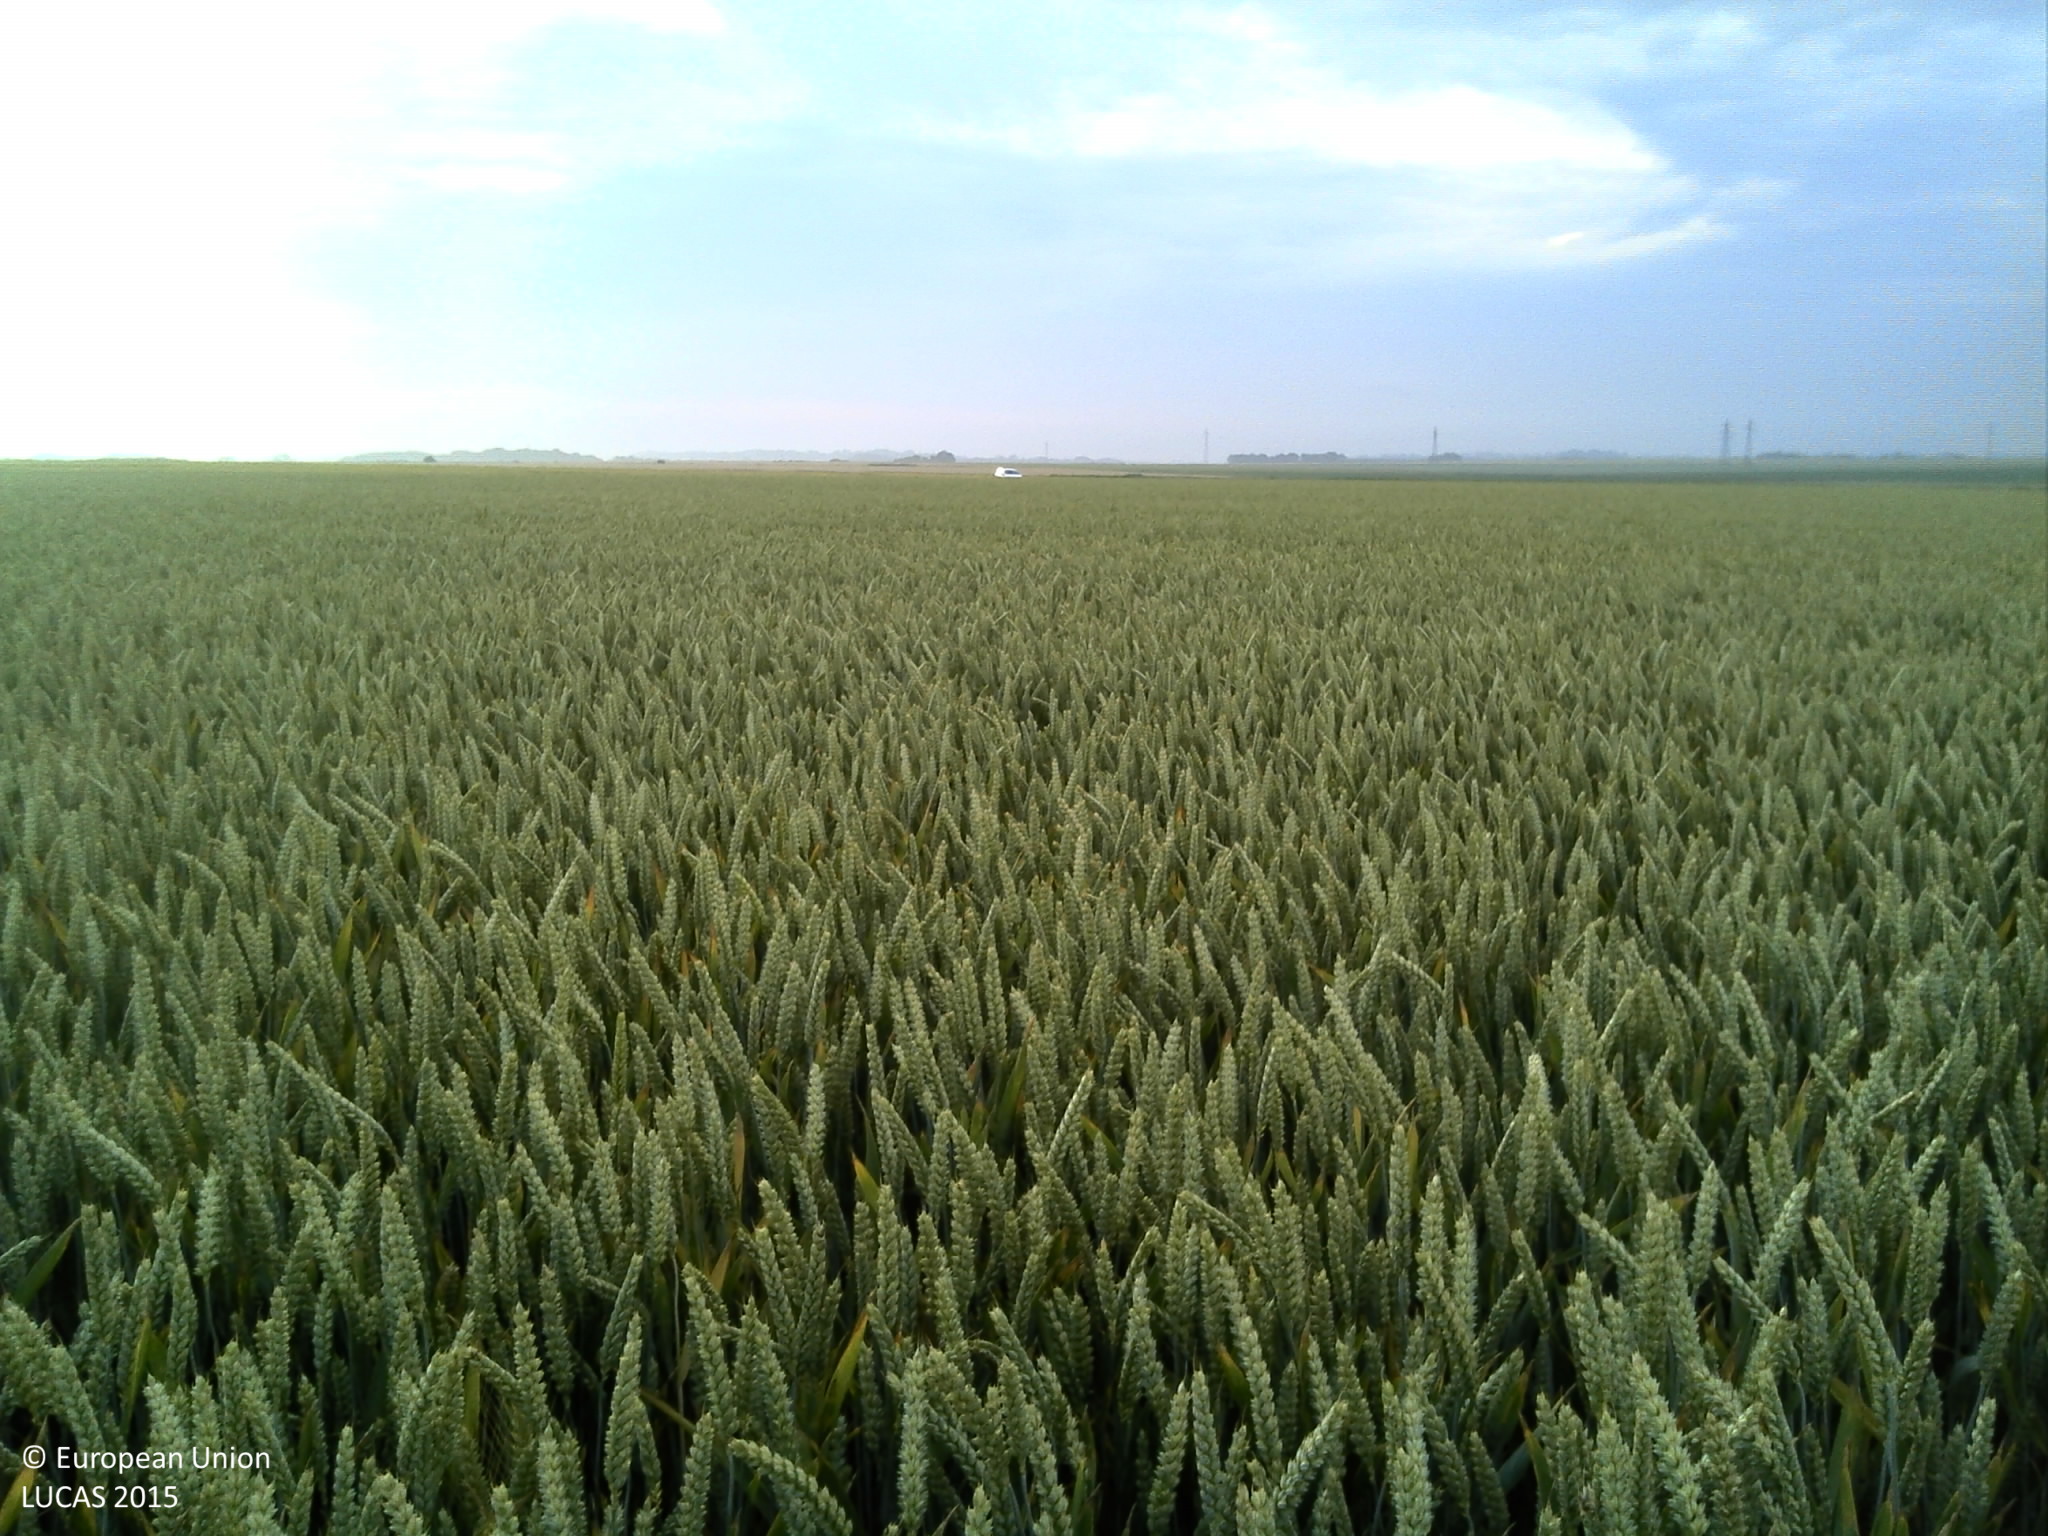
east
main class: Cropland
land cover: Common wheat
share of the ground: > 75 %
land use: Agriculture (excluding fallow land and kitchen gardens)
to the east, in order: Common wheat; Durum wheat; Grass margins; Paved roads, cycling and walking lanes; Grass margins; Sugar beet; Other fibre and oleaginous crops
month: July
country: FR
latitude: 49.8754
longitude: 0.9179
